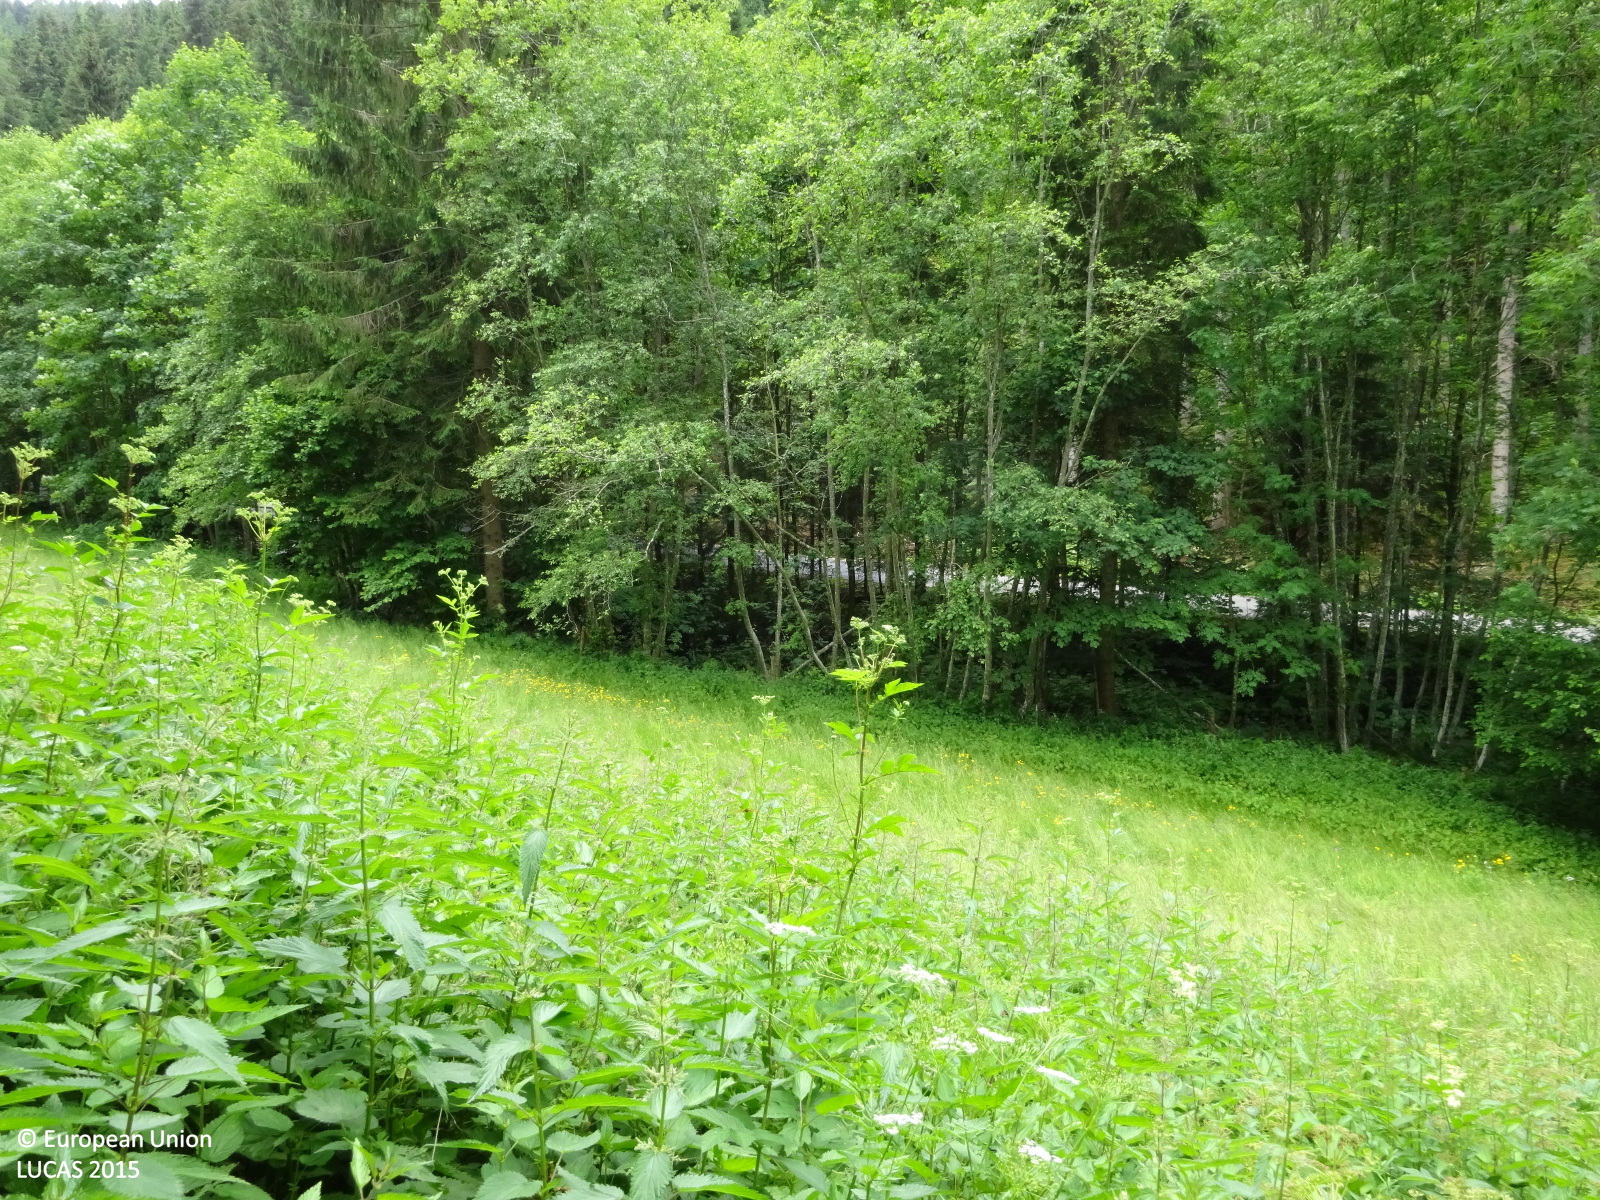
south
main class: Grassland
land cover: Grassland without tree/shrub cover
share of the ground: > 75 %
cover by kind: herbaceous plants 100 %
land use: Agriculture (excluding fallow land and kitchen gardens)
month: June
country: AT
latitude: 47.5887
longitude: 15.7063
